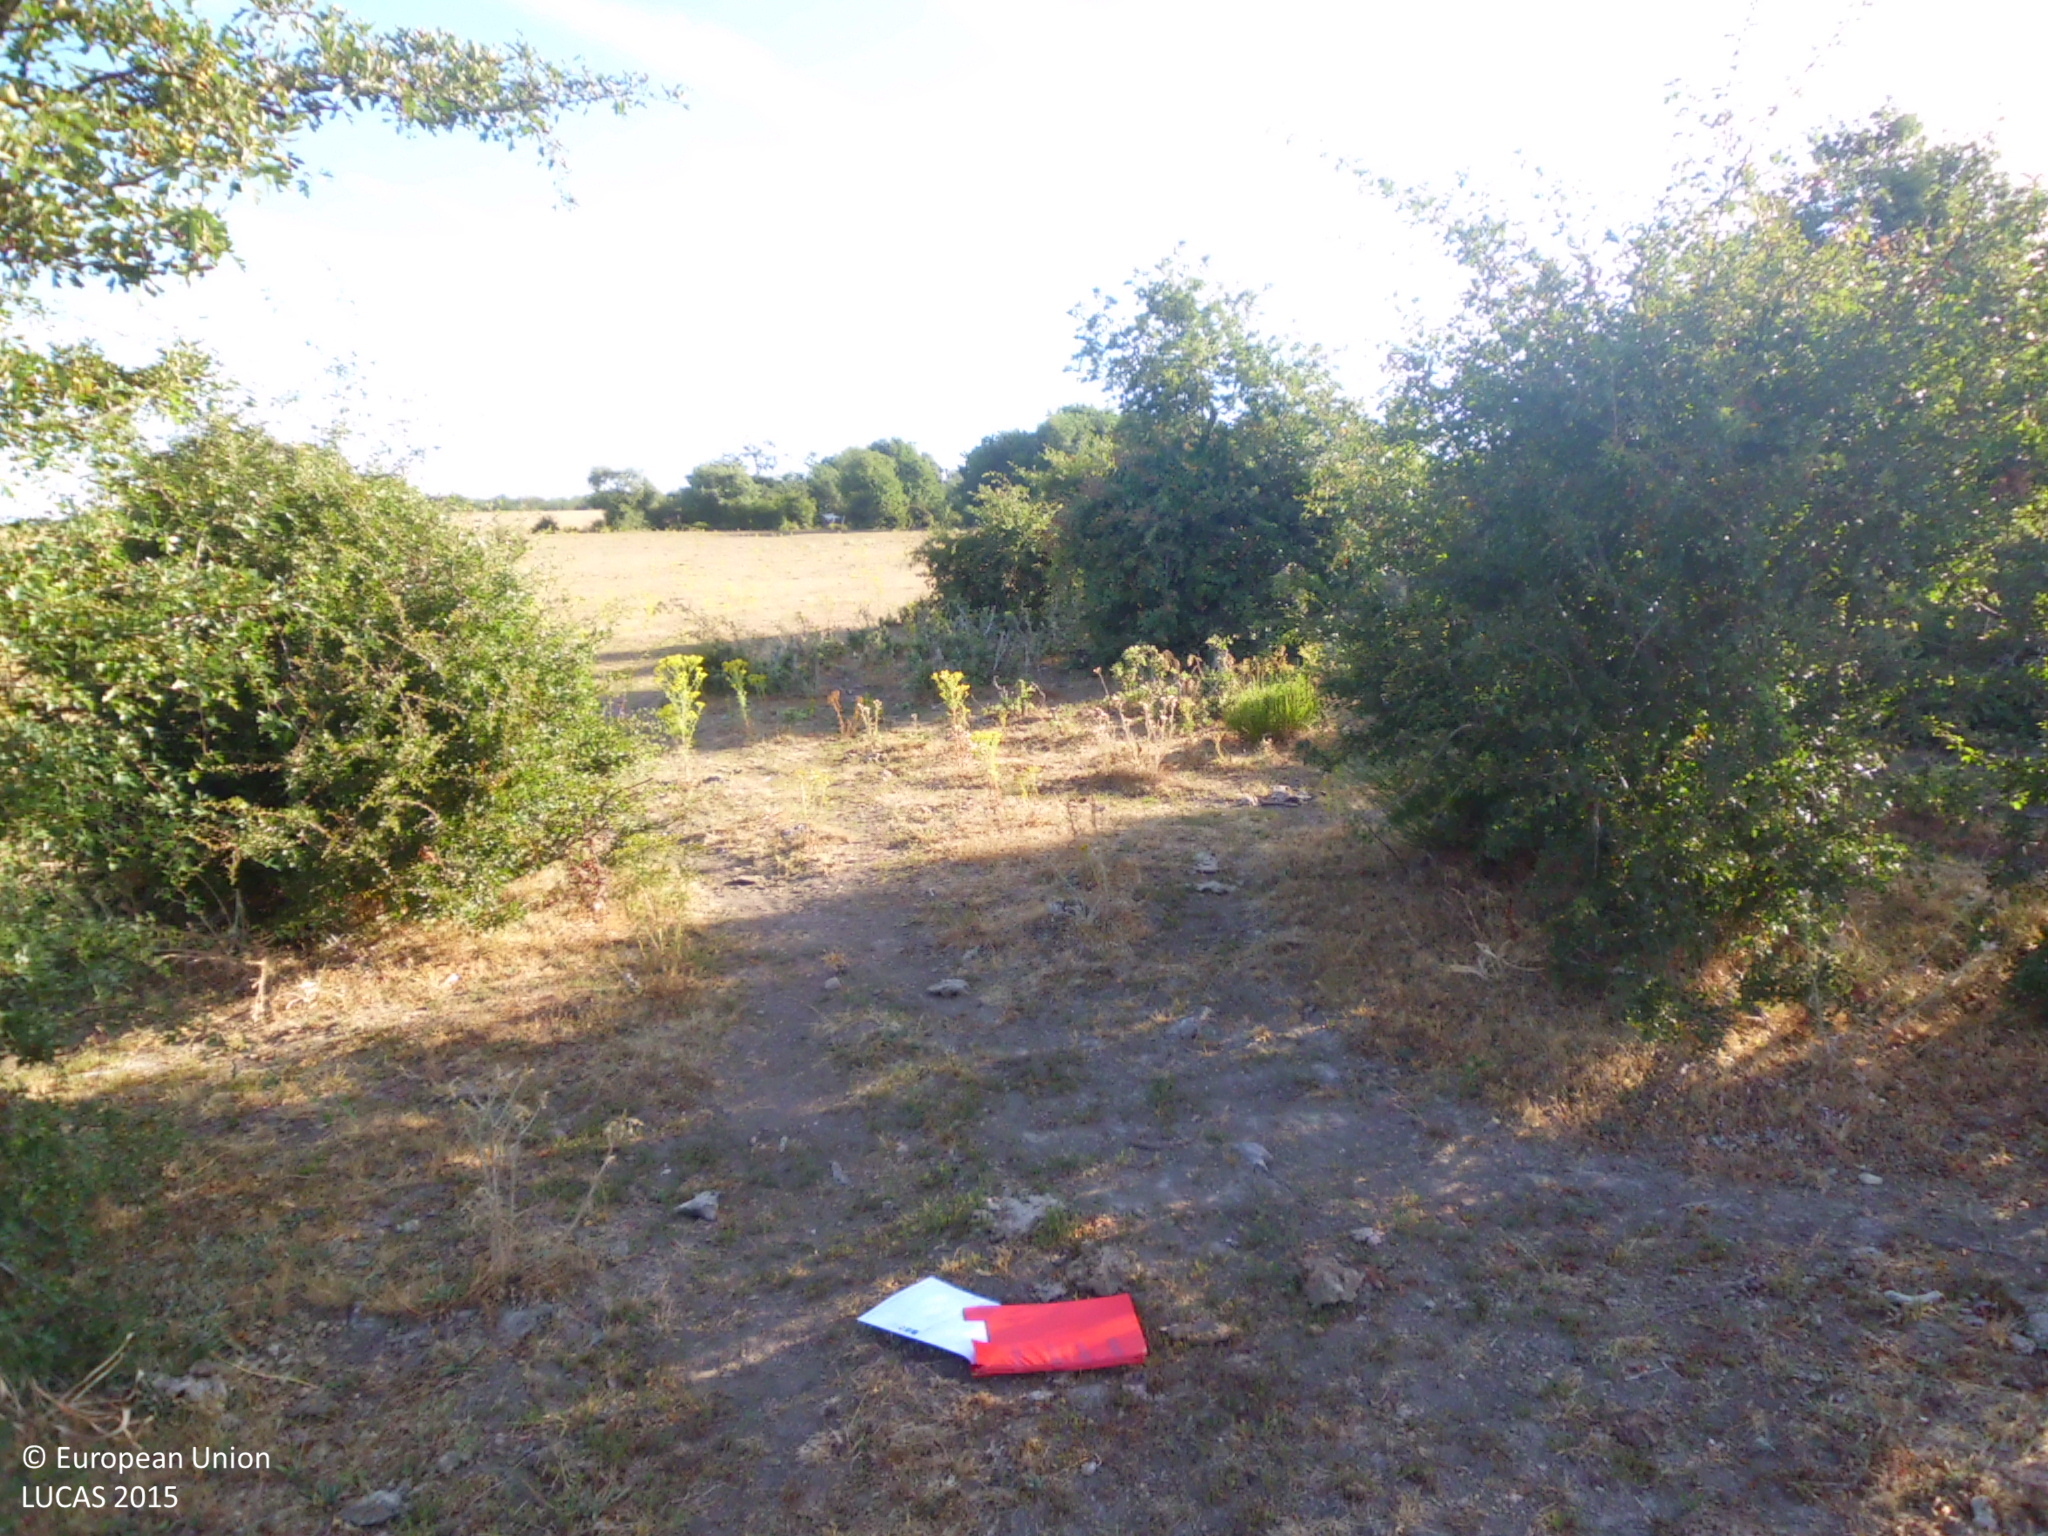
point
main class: Grassland
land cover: Grassland with sparse tree/shrub cover
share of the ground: 25 - 50 %
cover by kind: unconsolidated bare surface 50 %, herbaceous plants 40 %, broadleaved forest trees 5 %, shrubs 5 %
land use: Agriculture (excluding fallow land and kitchen gardens)
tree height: < 5 m
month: July
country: ES
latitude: 42.6995
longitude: -4.2709
